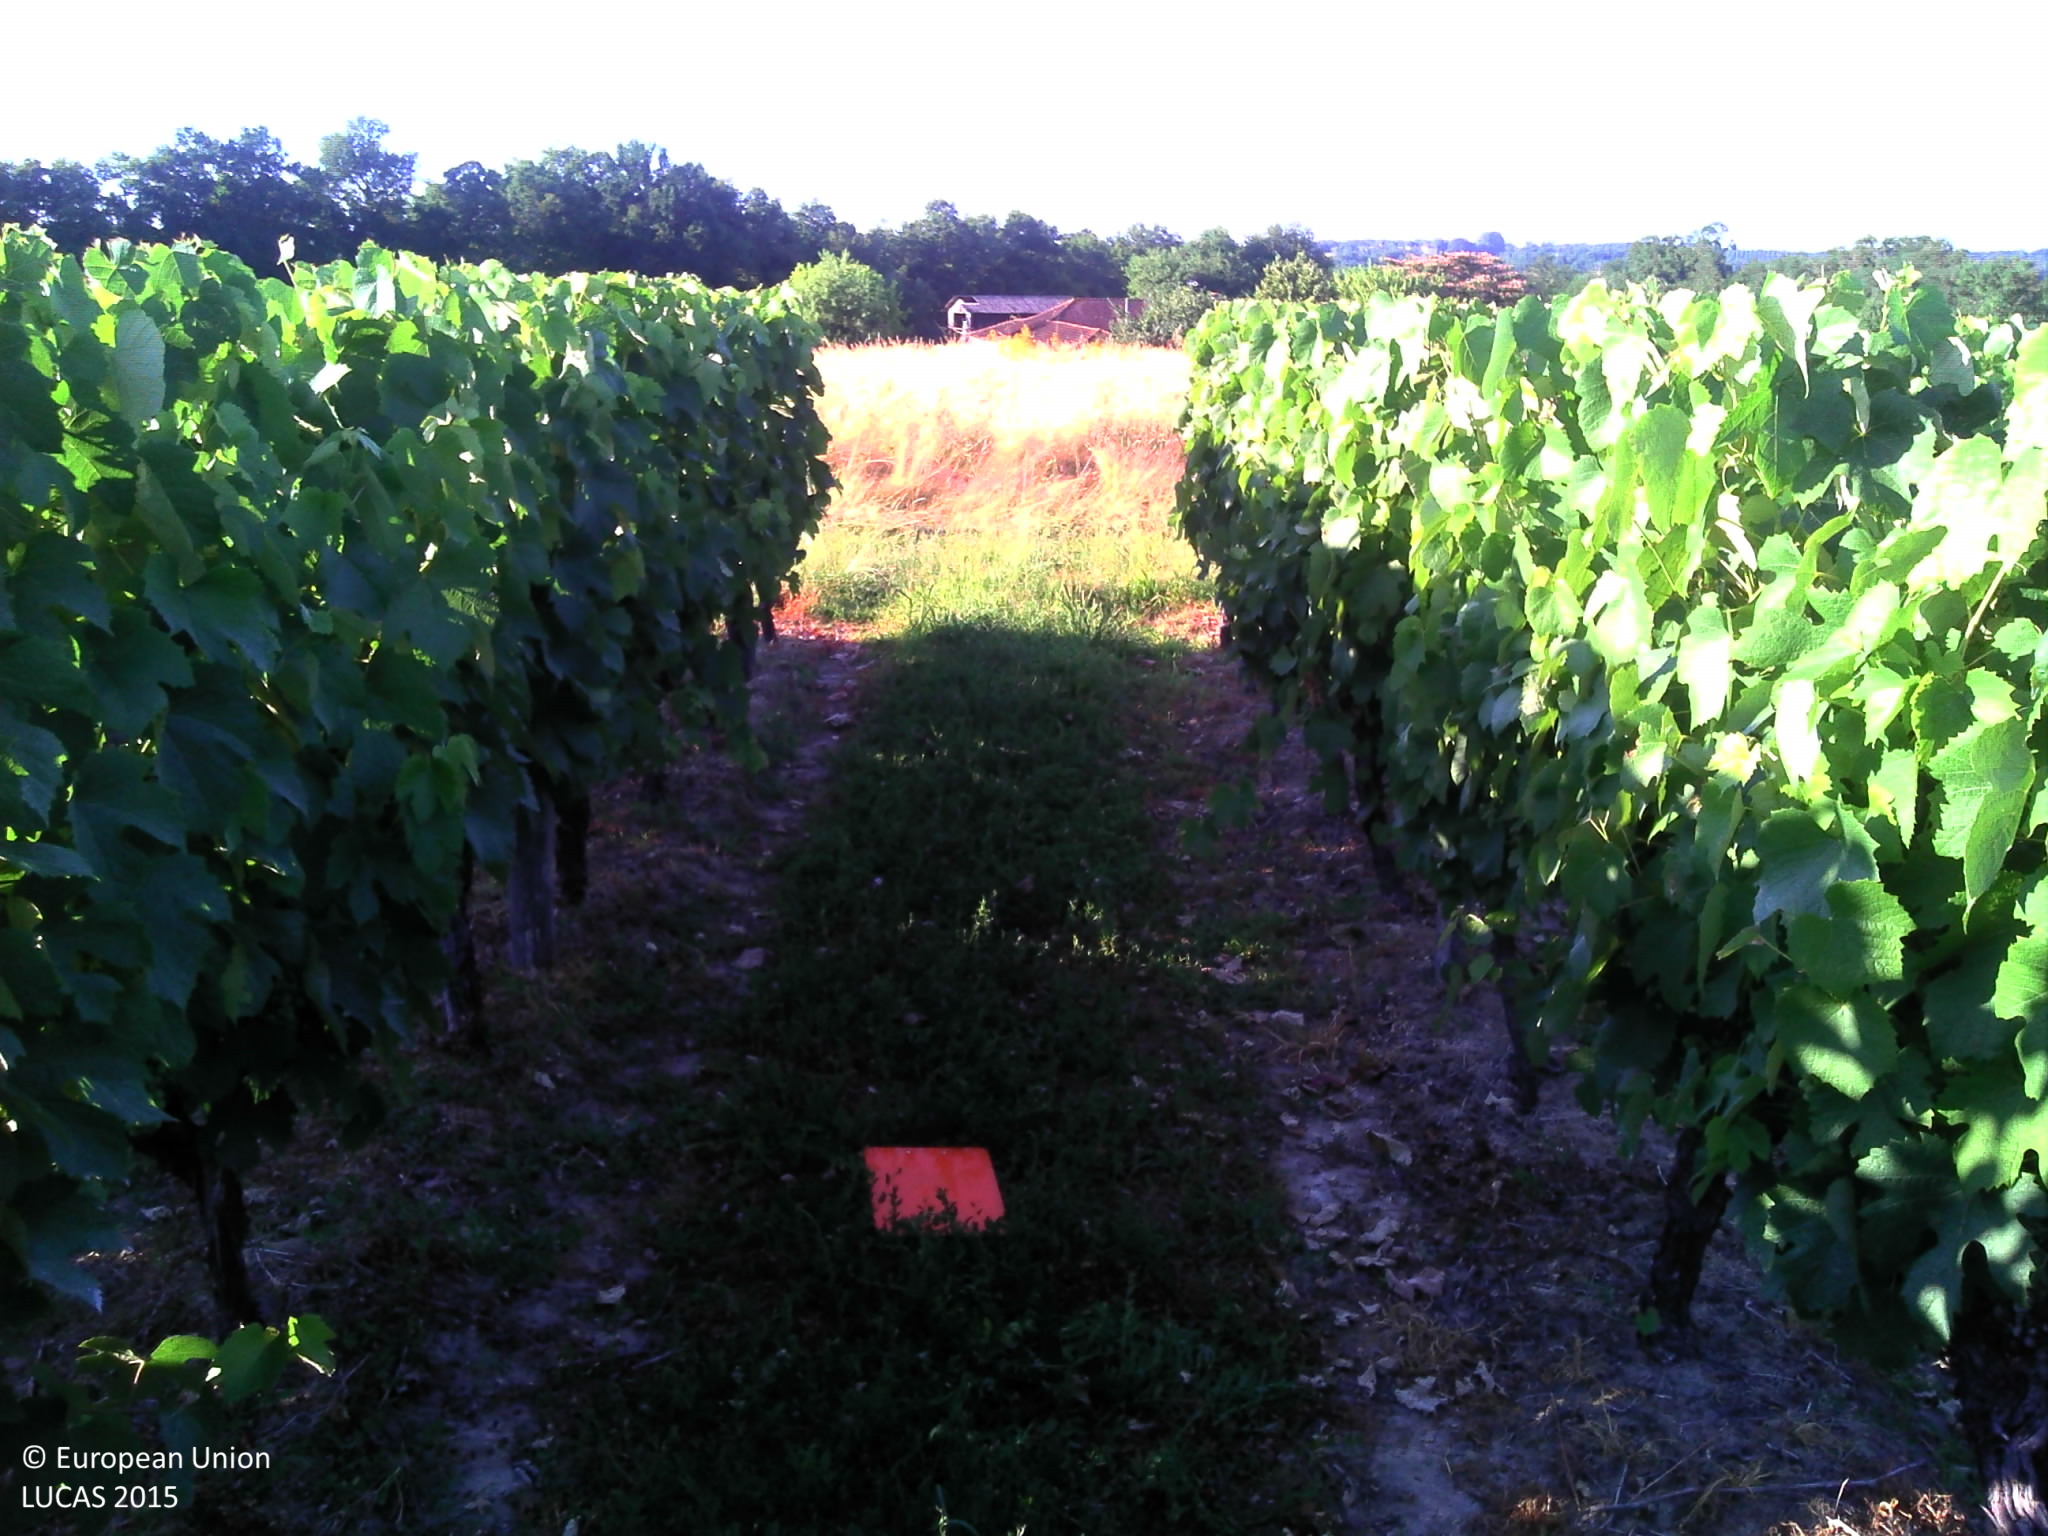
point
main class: Cropland
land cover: Vineyards
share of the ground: 25 - 50 %
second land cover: Grassland without tree/shrub cover
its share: 25 - 50 %
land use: Agriculture (excluding fallow land and kitchen gardens)
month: July
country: FR
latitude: 43.8957
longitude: -0.2555
